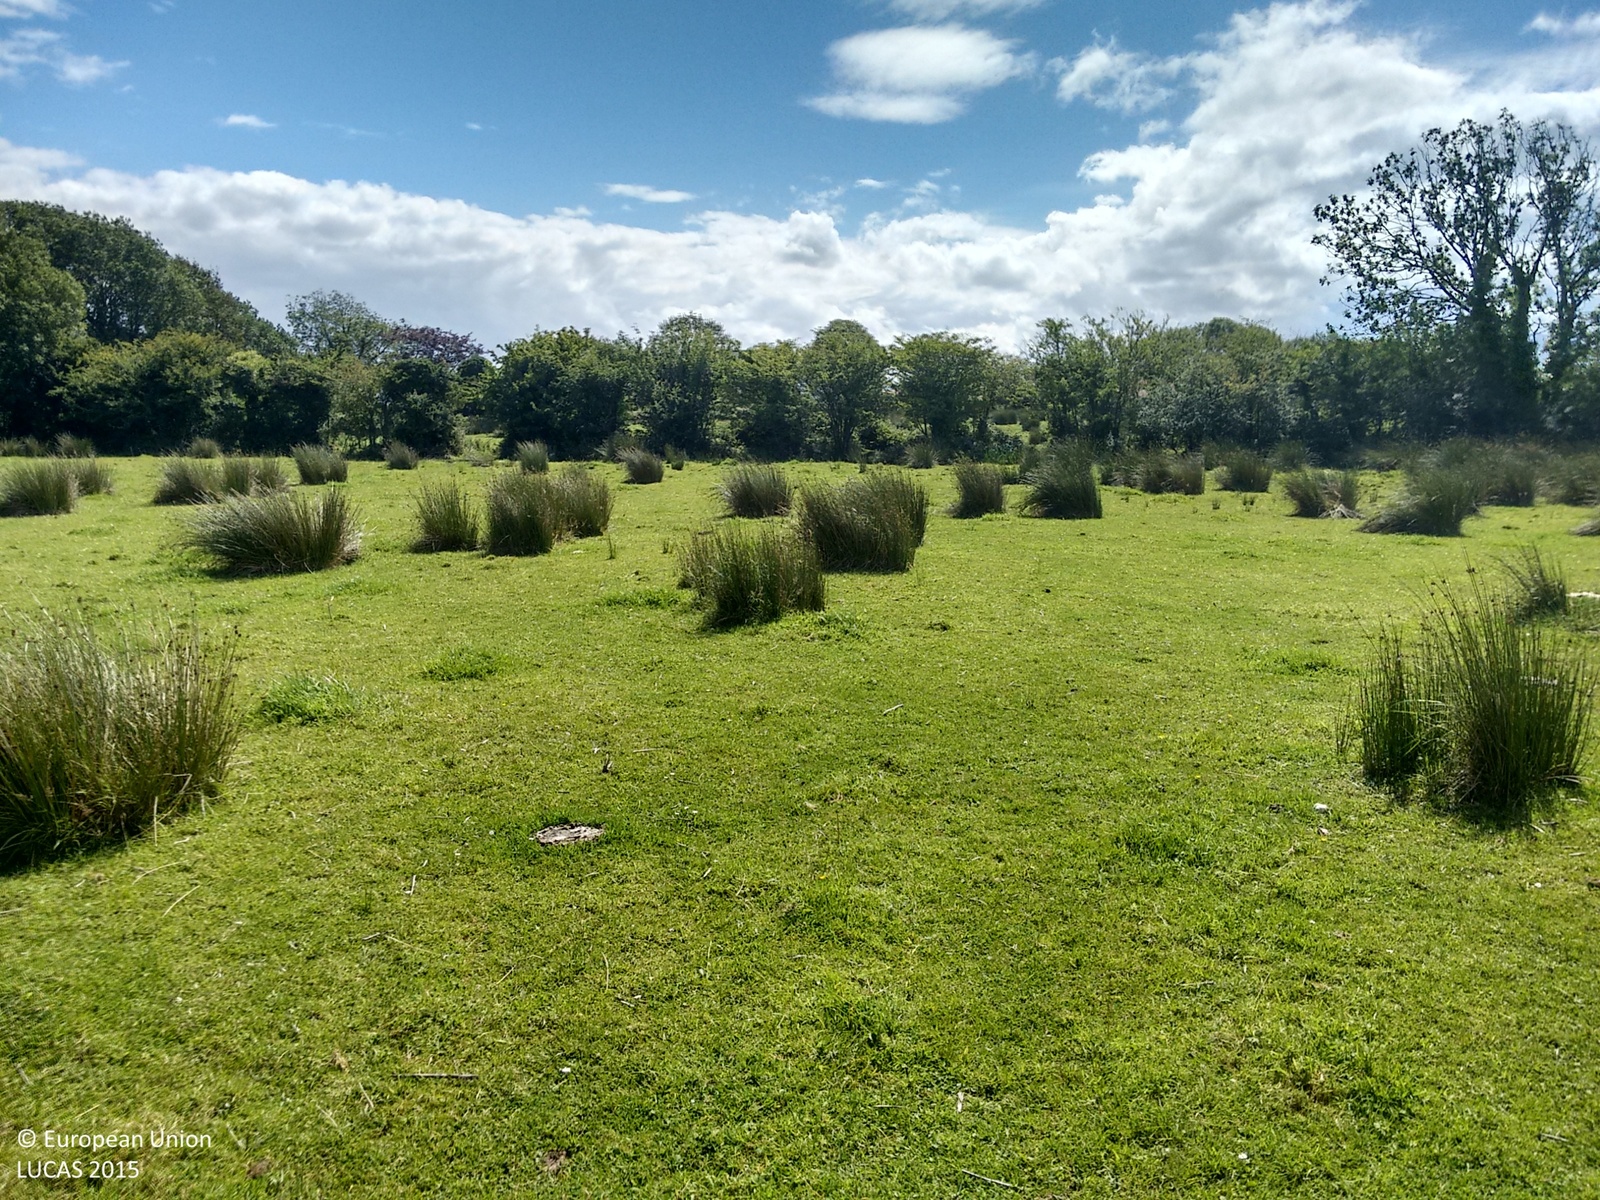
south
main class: Grassland
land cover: Grassland without tree/shrub cover
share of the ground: > 75 %
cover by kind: herbaceous plants 100 %
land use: Agriculture (excluding fallow land and kitchen gardens)
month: August
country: IE
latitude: 52.1740
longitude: -9.7654
